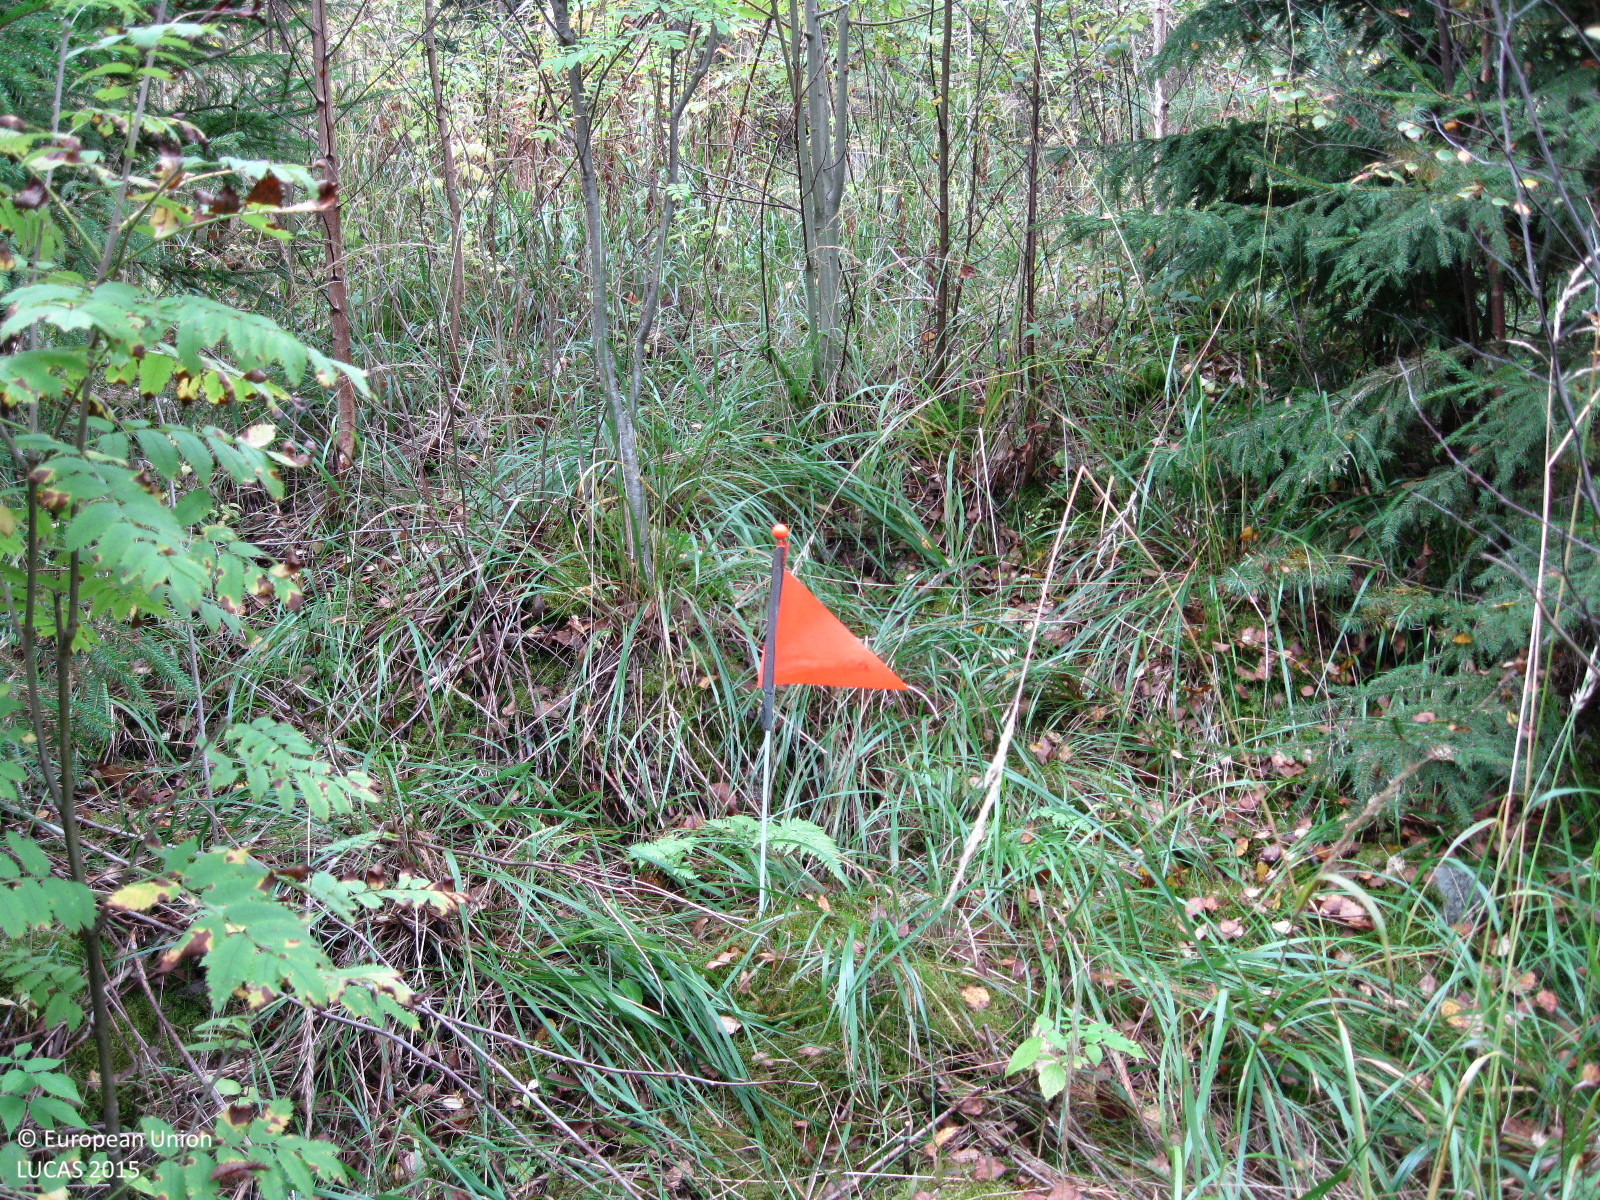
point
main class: Woodland
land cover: Broadleaved woodland
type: boreal forest
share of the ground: > 75 %
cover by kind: broadleaved forest trees 80 %, herbaceous plants 10 %, coniferous forest trees 5 %, shrubs 5 %
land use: Forestry
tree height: > 5 m
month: September
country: FI
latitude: 60.7973
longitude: 24.9040
